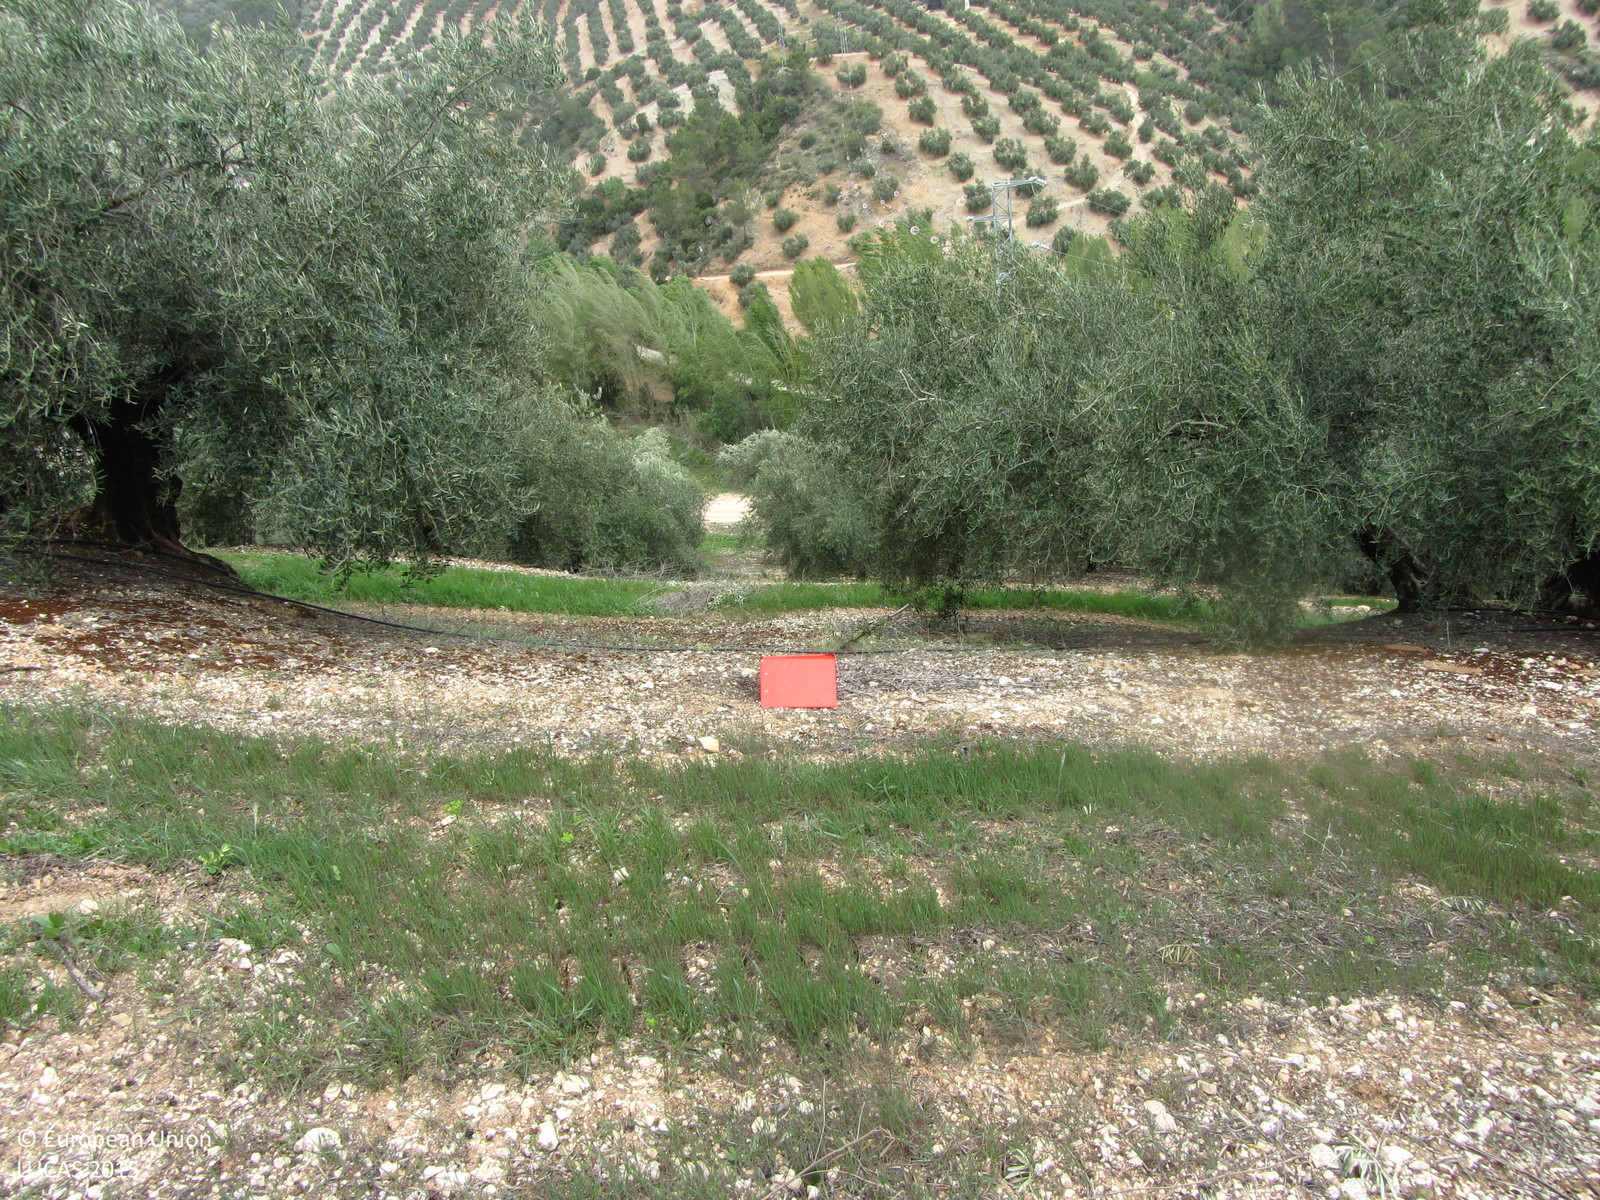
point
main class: Cropland
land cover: Olive groves
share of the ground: 50 - 75 %
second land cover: Spontaneously vegetated surfaces
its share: 10 - 25 %
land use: Agriculture (excluding fallow land and kitchen gardens)
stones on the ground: > 50 %
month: April
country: ES
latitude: 38.0820
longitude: -2.9828
